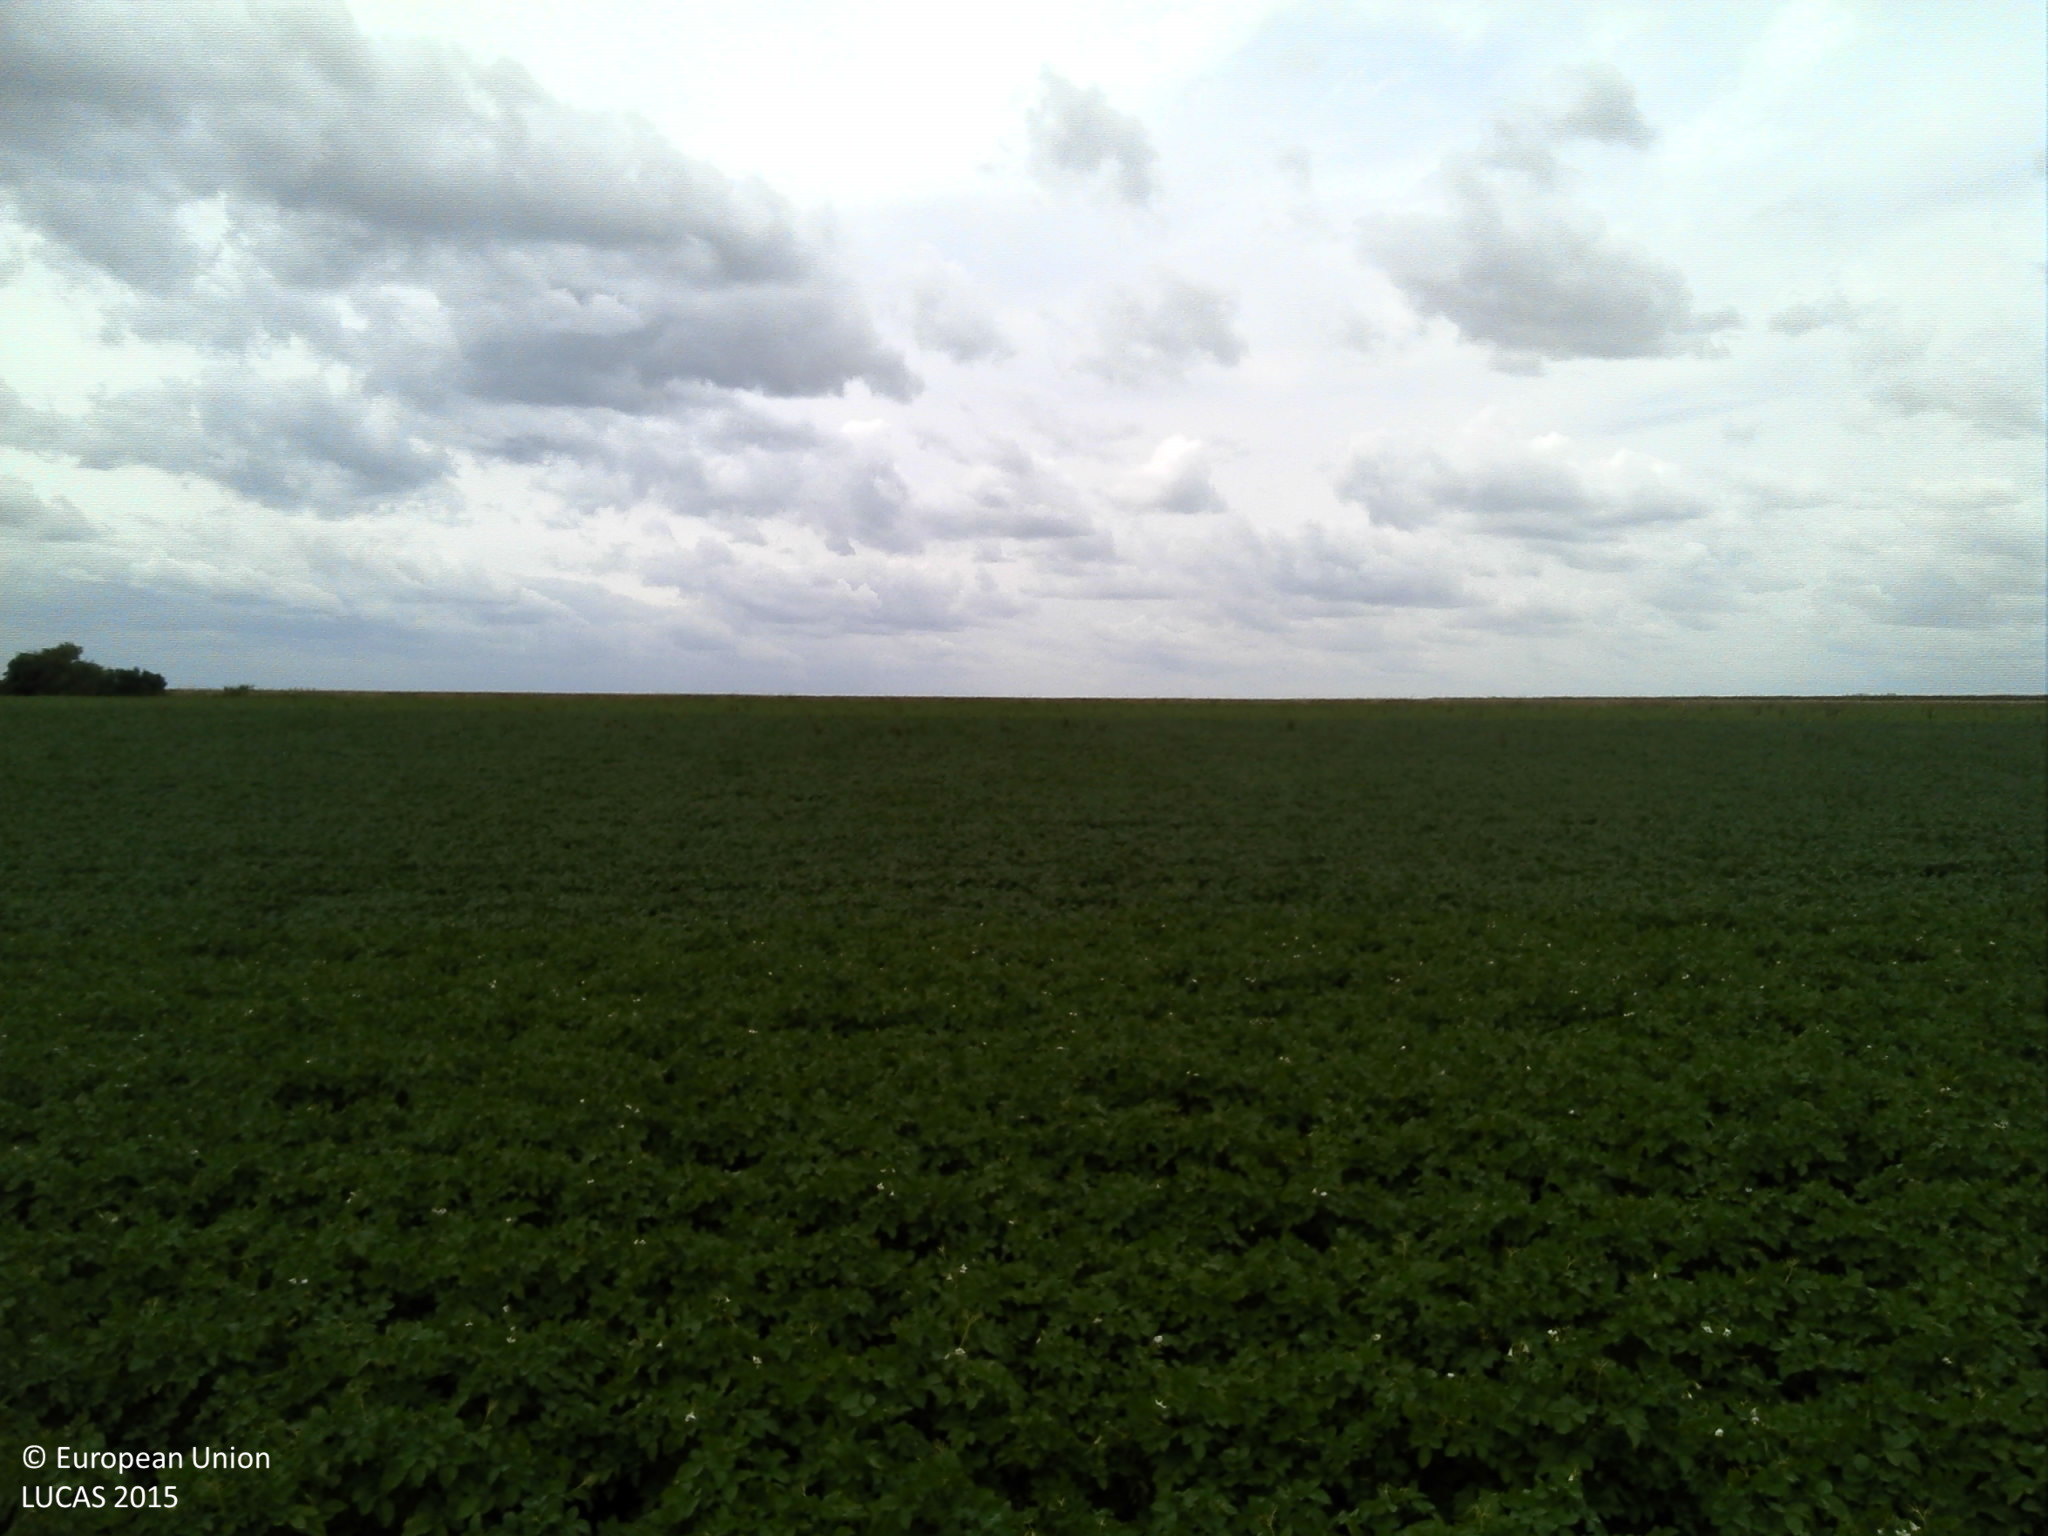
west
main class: Cropland
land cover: Potatoes
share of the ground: > 75 %
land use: Agriculture (excluding fallow land and kitchen gardens)
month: July
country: FR
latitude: 49.6145
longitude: 4.0573
